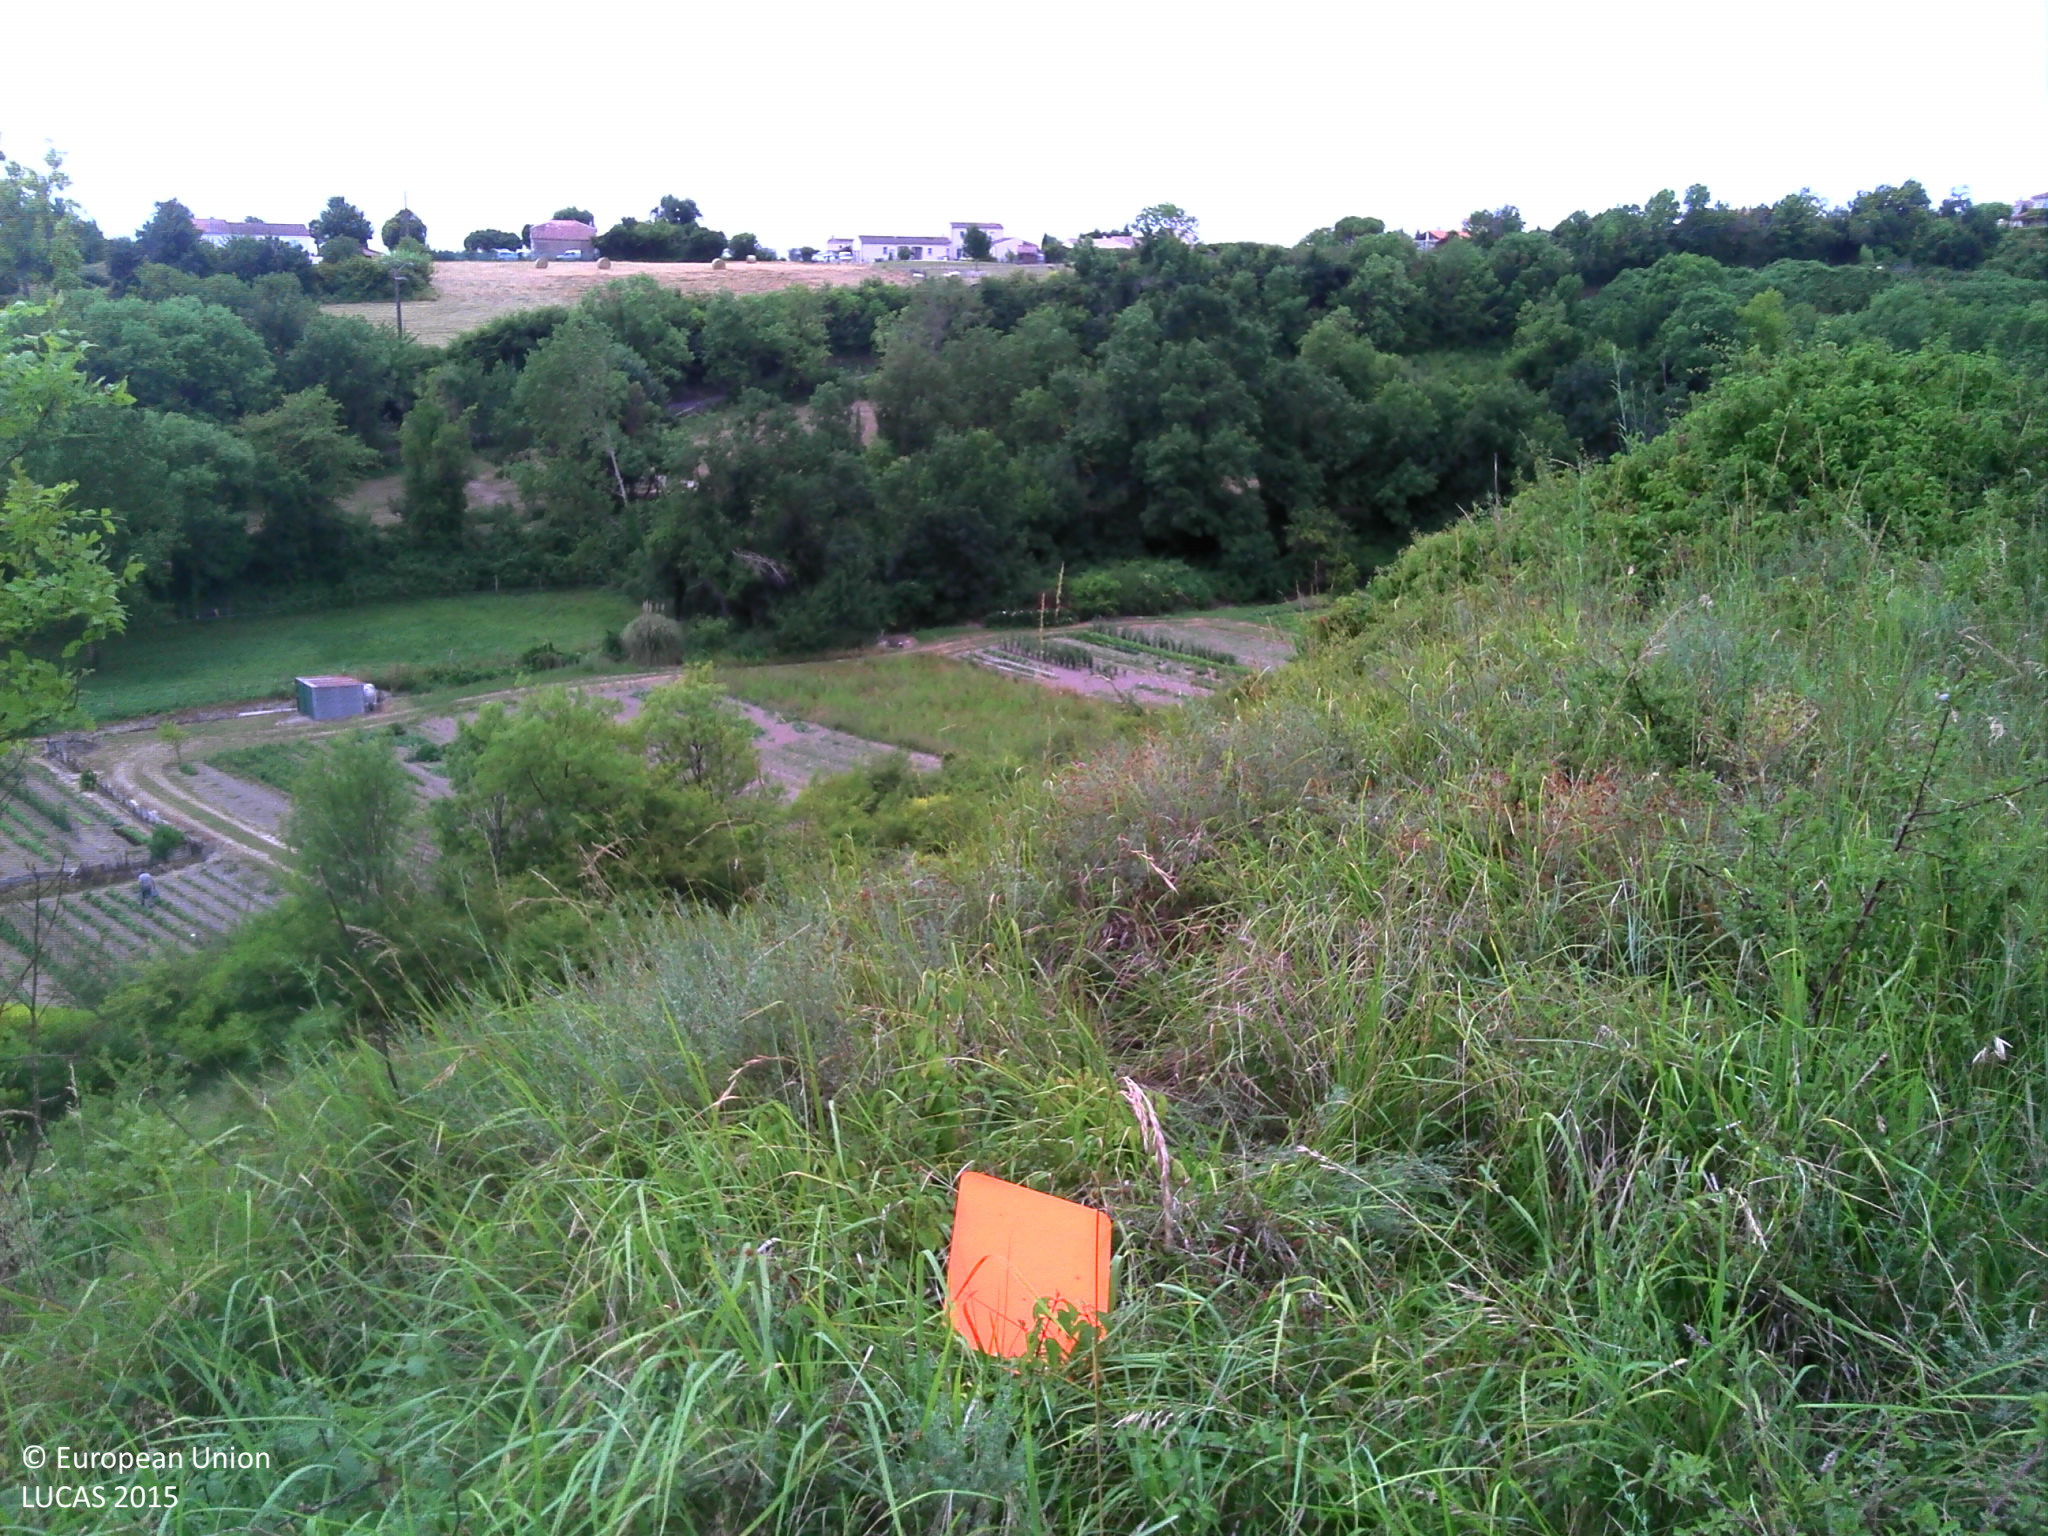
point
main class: Shrubland
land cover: Shrubland without tree cover
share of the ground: > 75 %
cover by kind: shrubs 100 %
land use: Sport
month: July
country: FR
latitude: 45.4775
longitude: -0.7828
